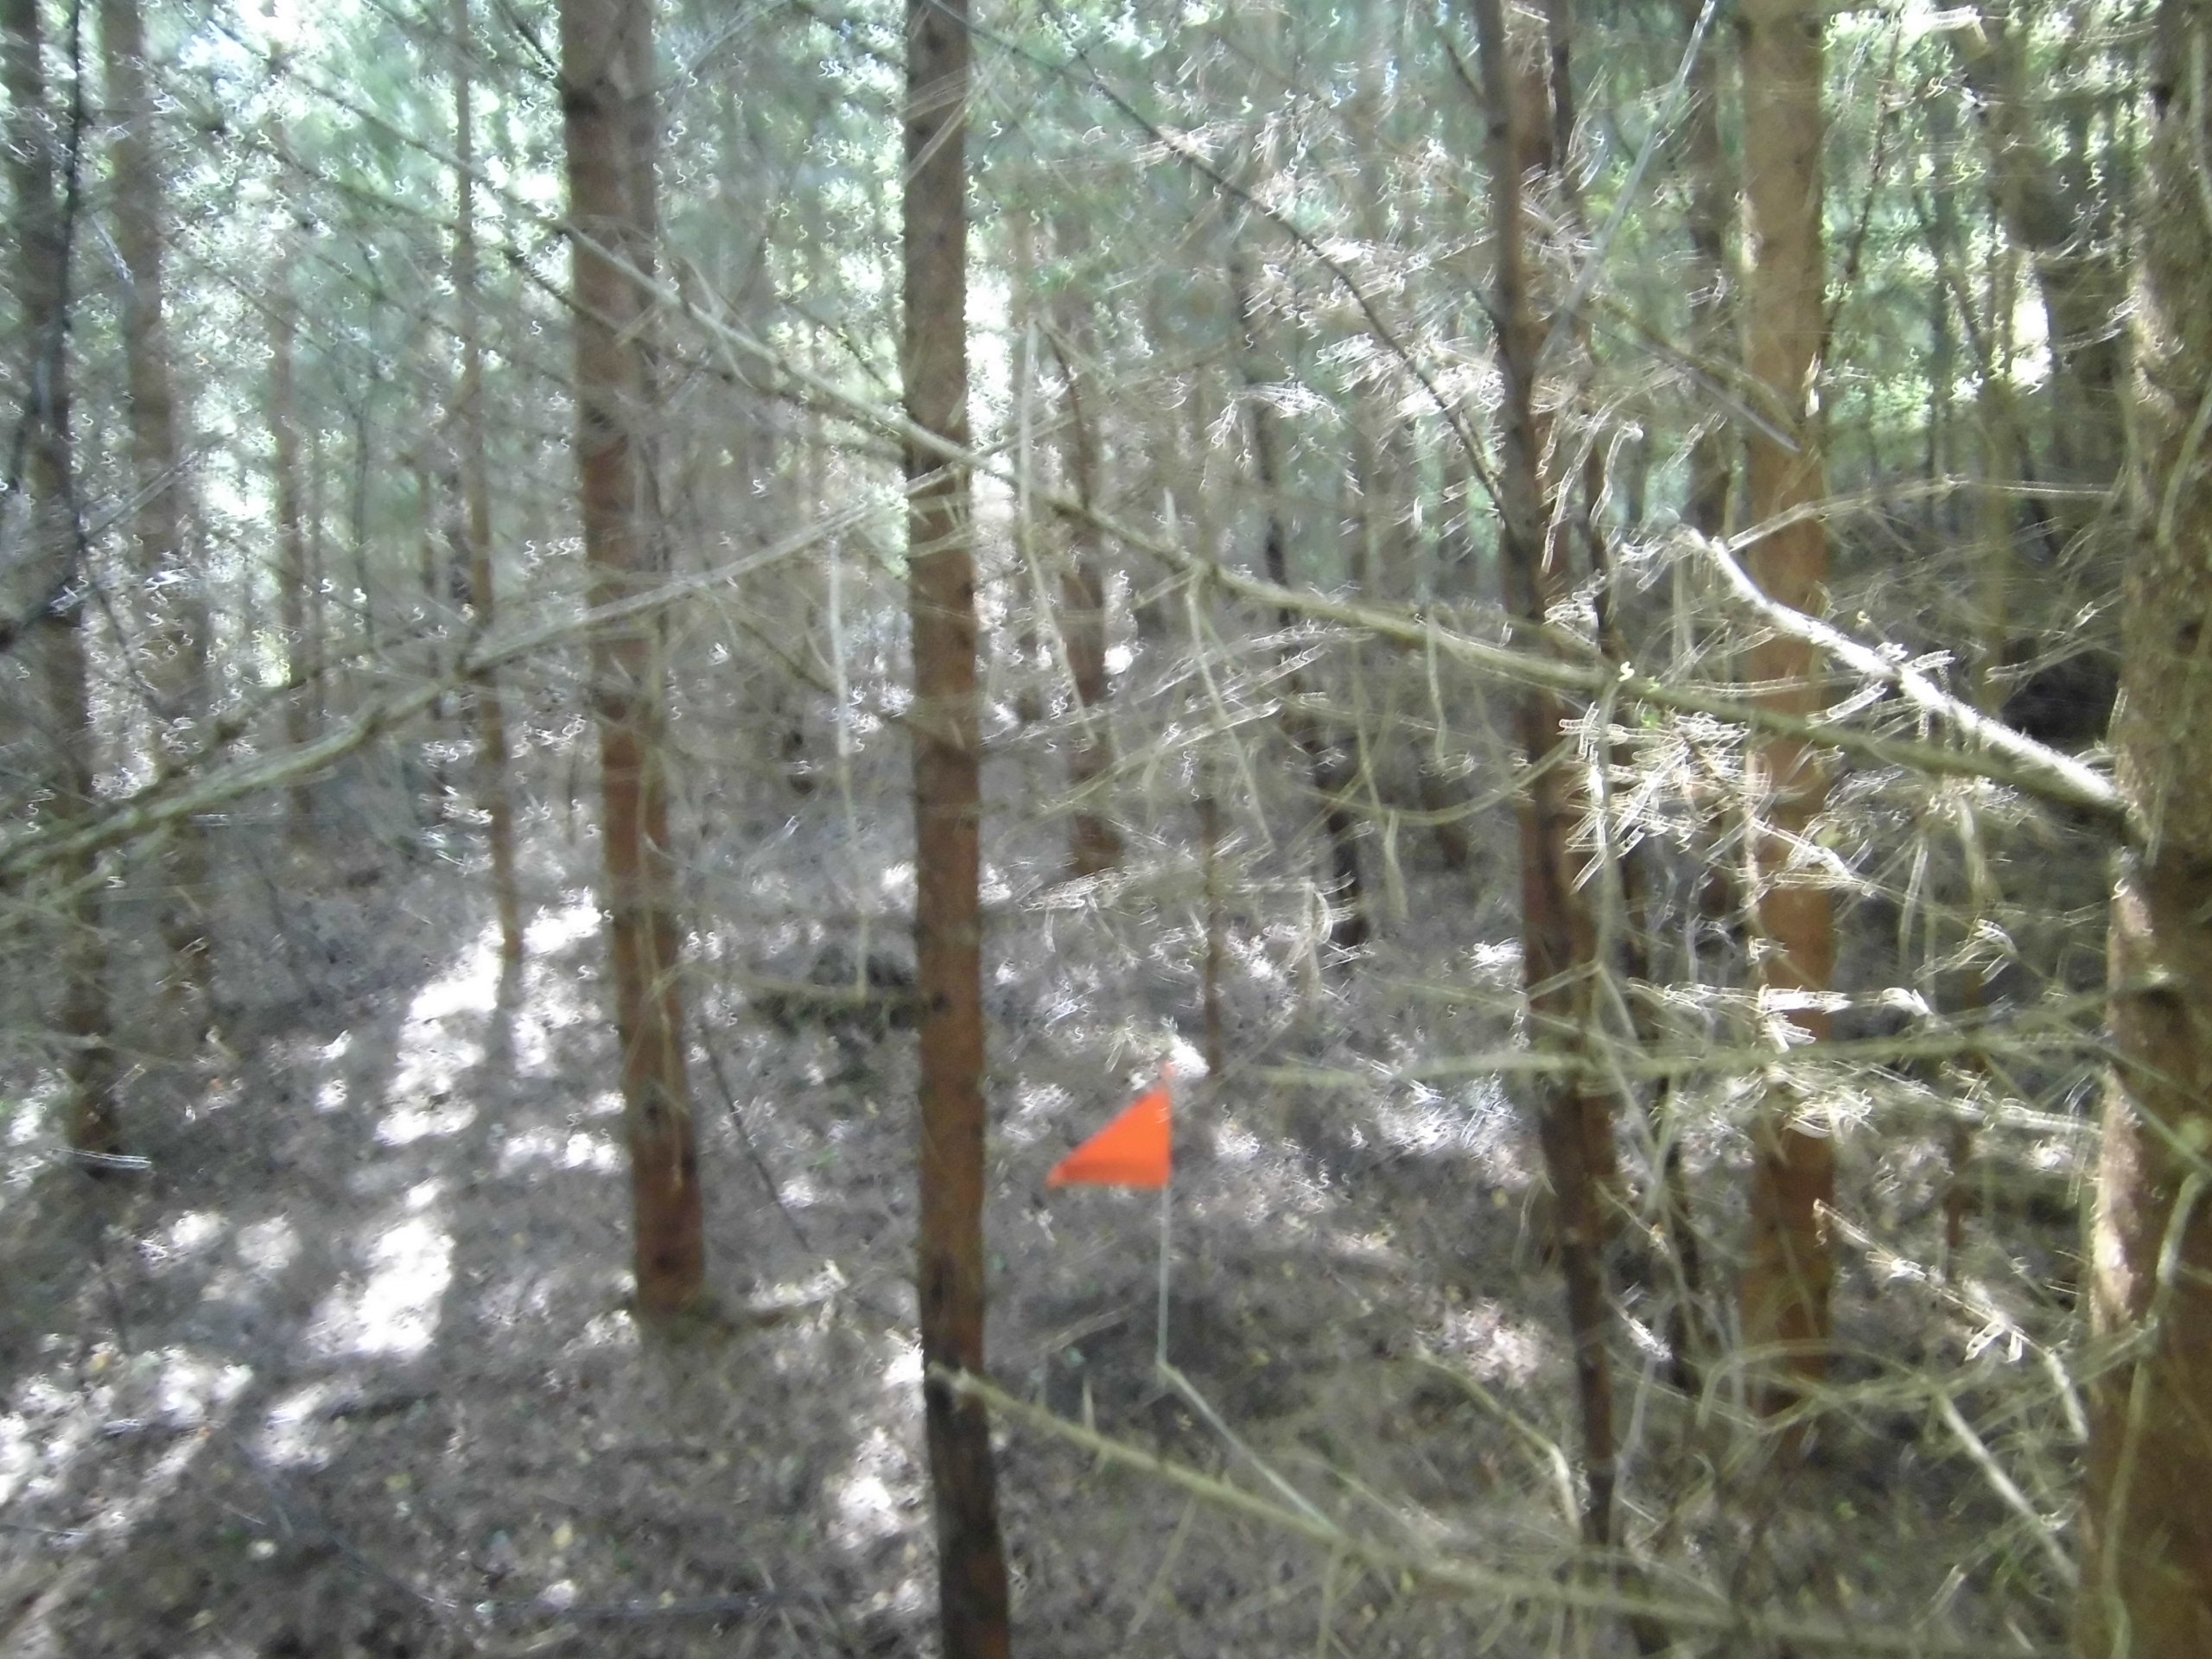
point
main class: Woodland
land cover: Spruce dominated coniferous woodland
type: boreal forest
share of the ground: > 75 %
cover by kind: coniferous forest trees 75 %, unconsolidated bare surface 15 %, broadleaved forest trees 5 %, lichens and mosses 5 %
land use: Forestry
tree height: > 5 m
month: July
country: SE
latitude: 57.3153
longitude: 15.4597
